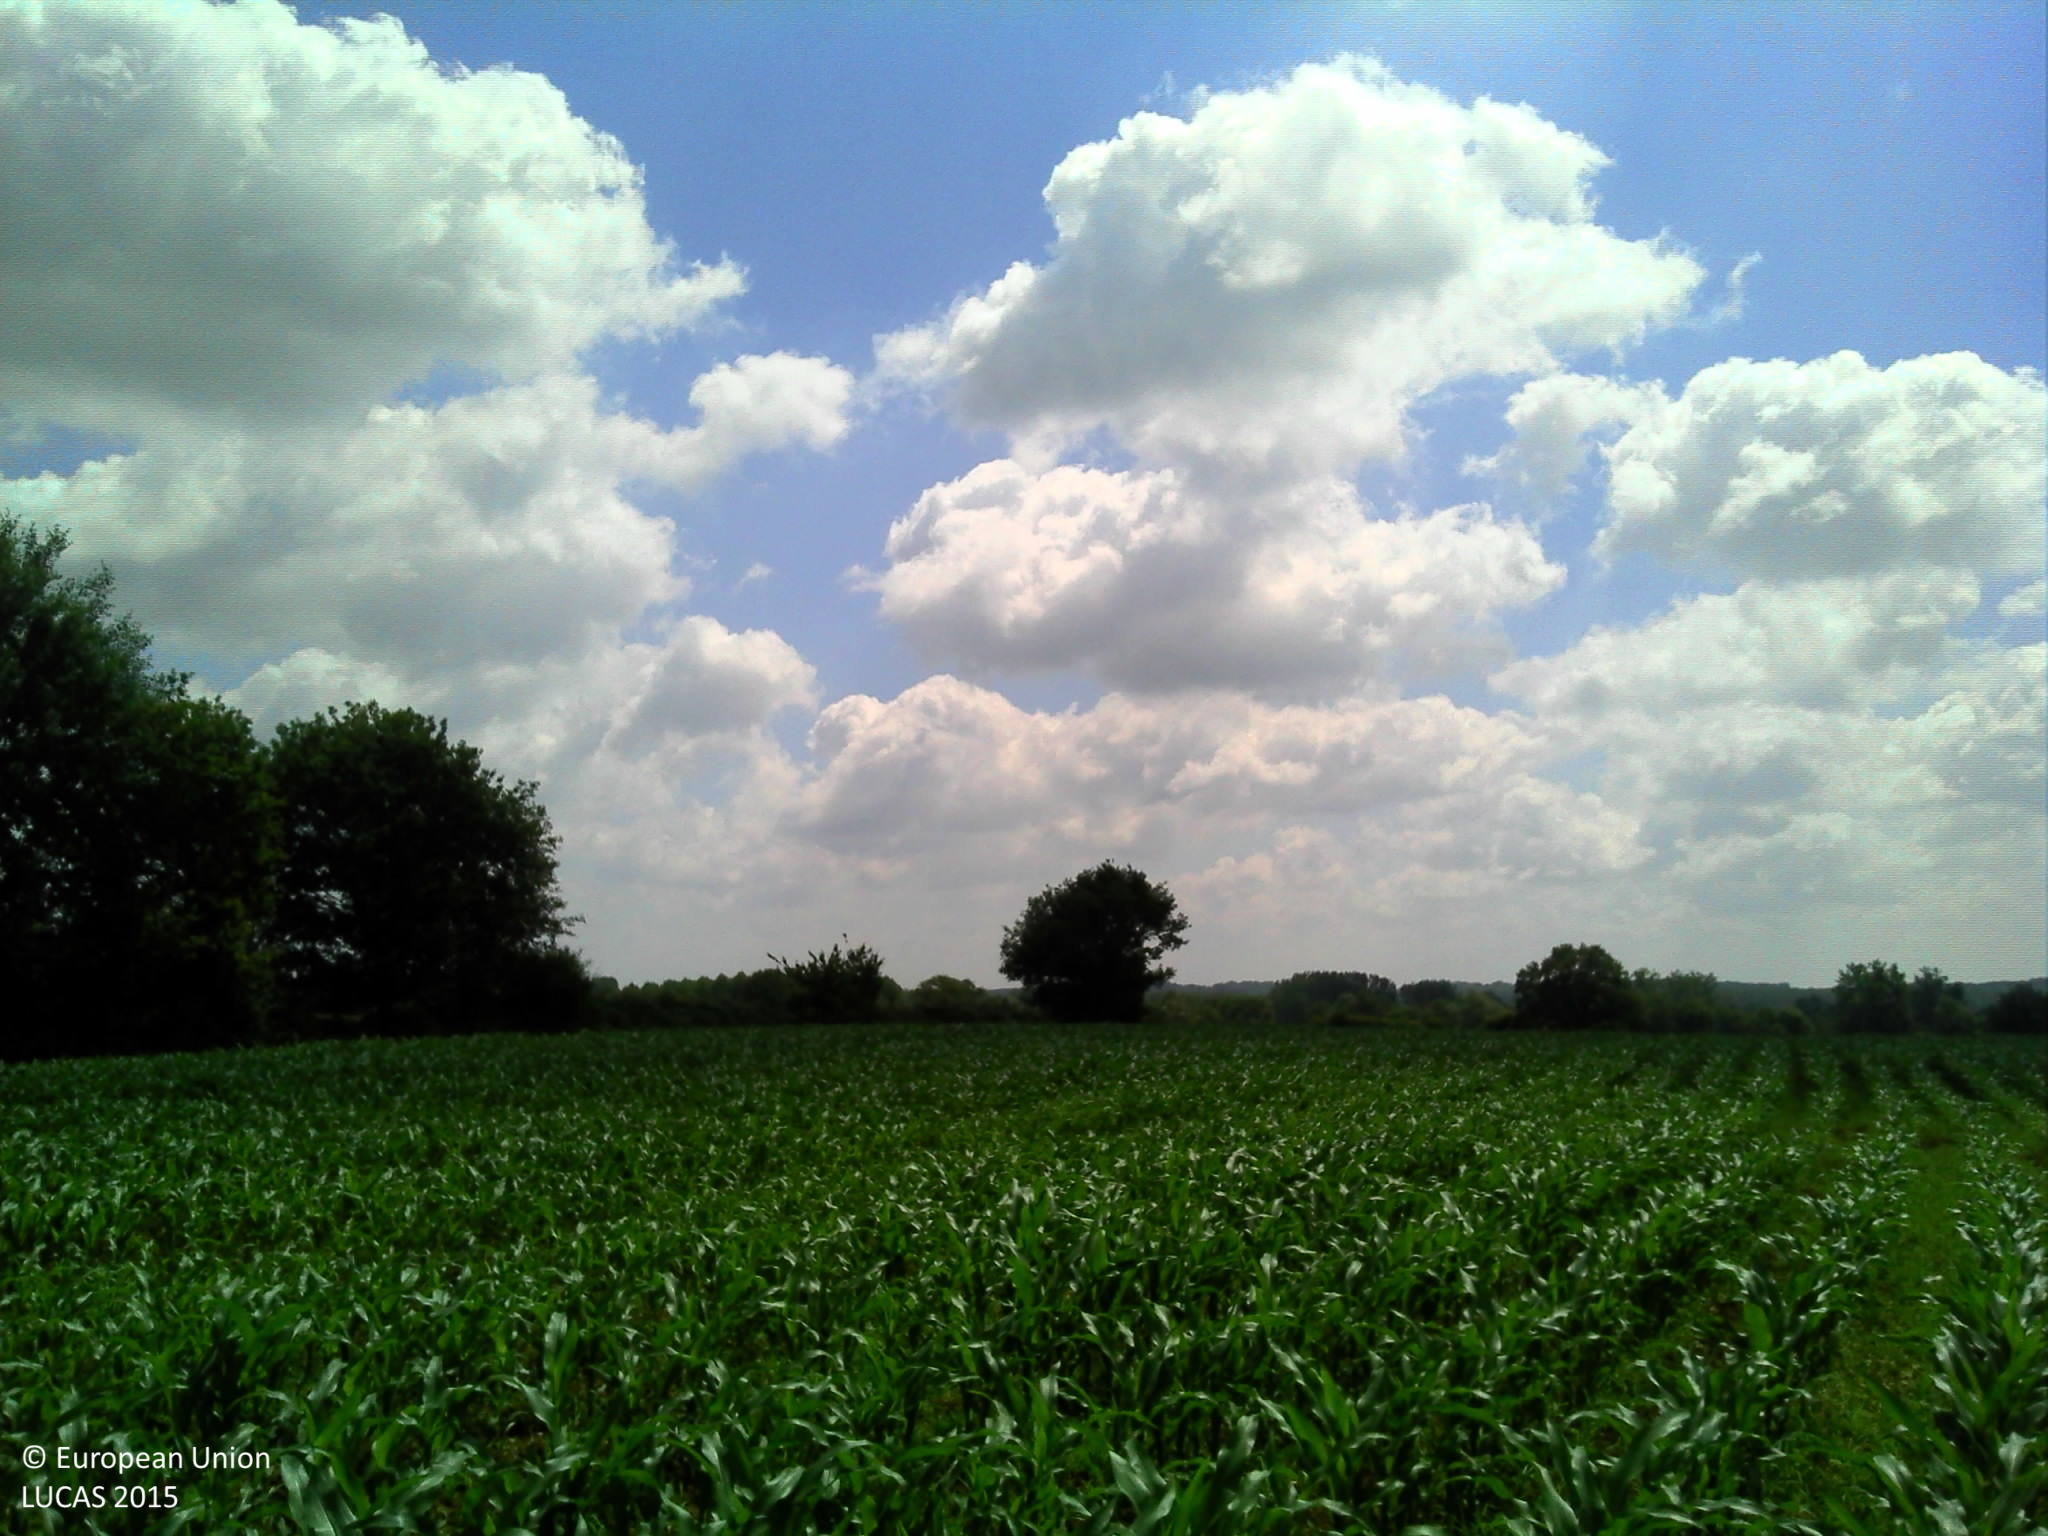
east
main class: Cropland
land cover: Maize
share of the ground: 25 - 50 %
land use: Agriculture (excluding fallow land and kitchen gardens)
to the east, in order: Maize; Managed hedges; Ditches and canals; Common wheat
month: June
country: FR
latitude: 48.2091
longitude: 0.2715
